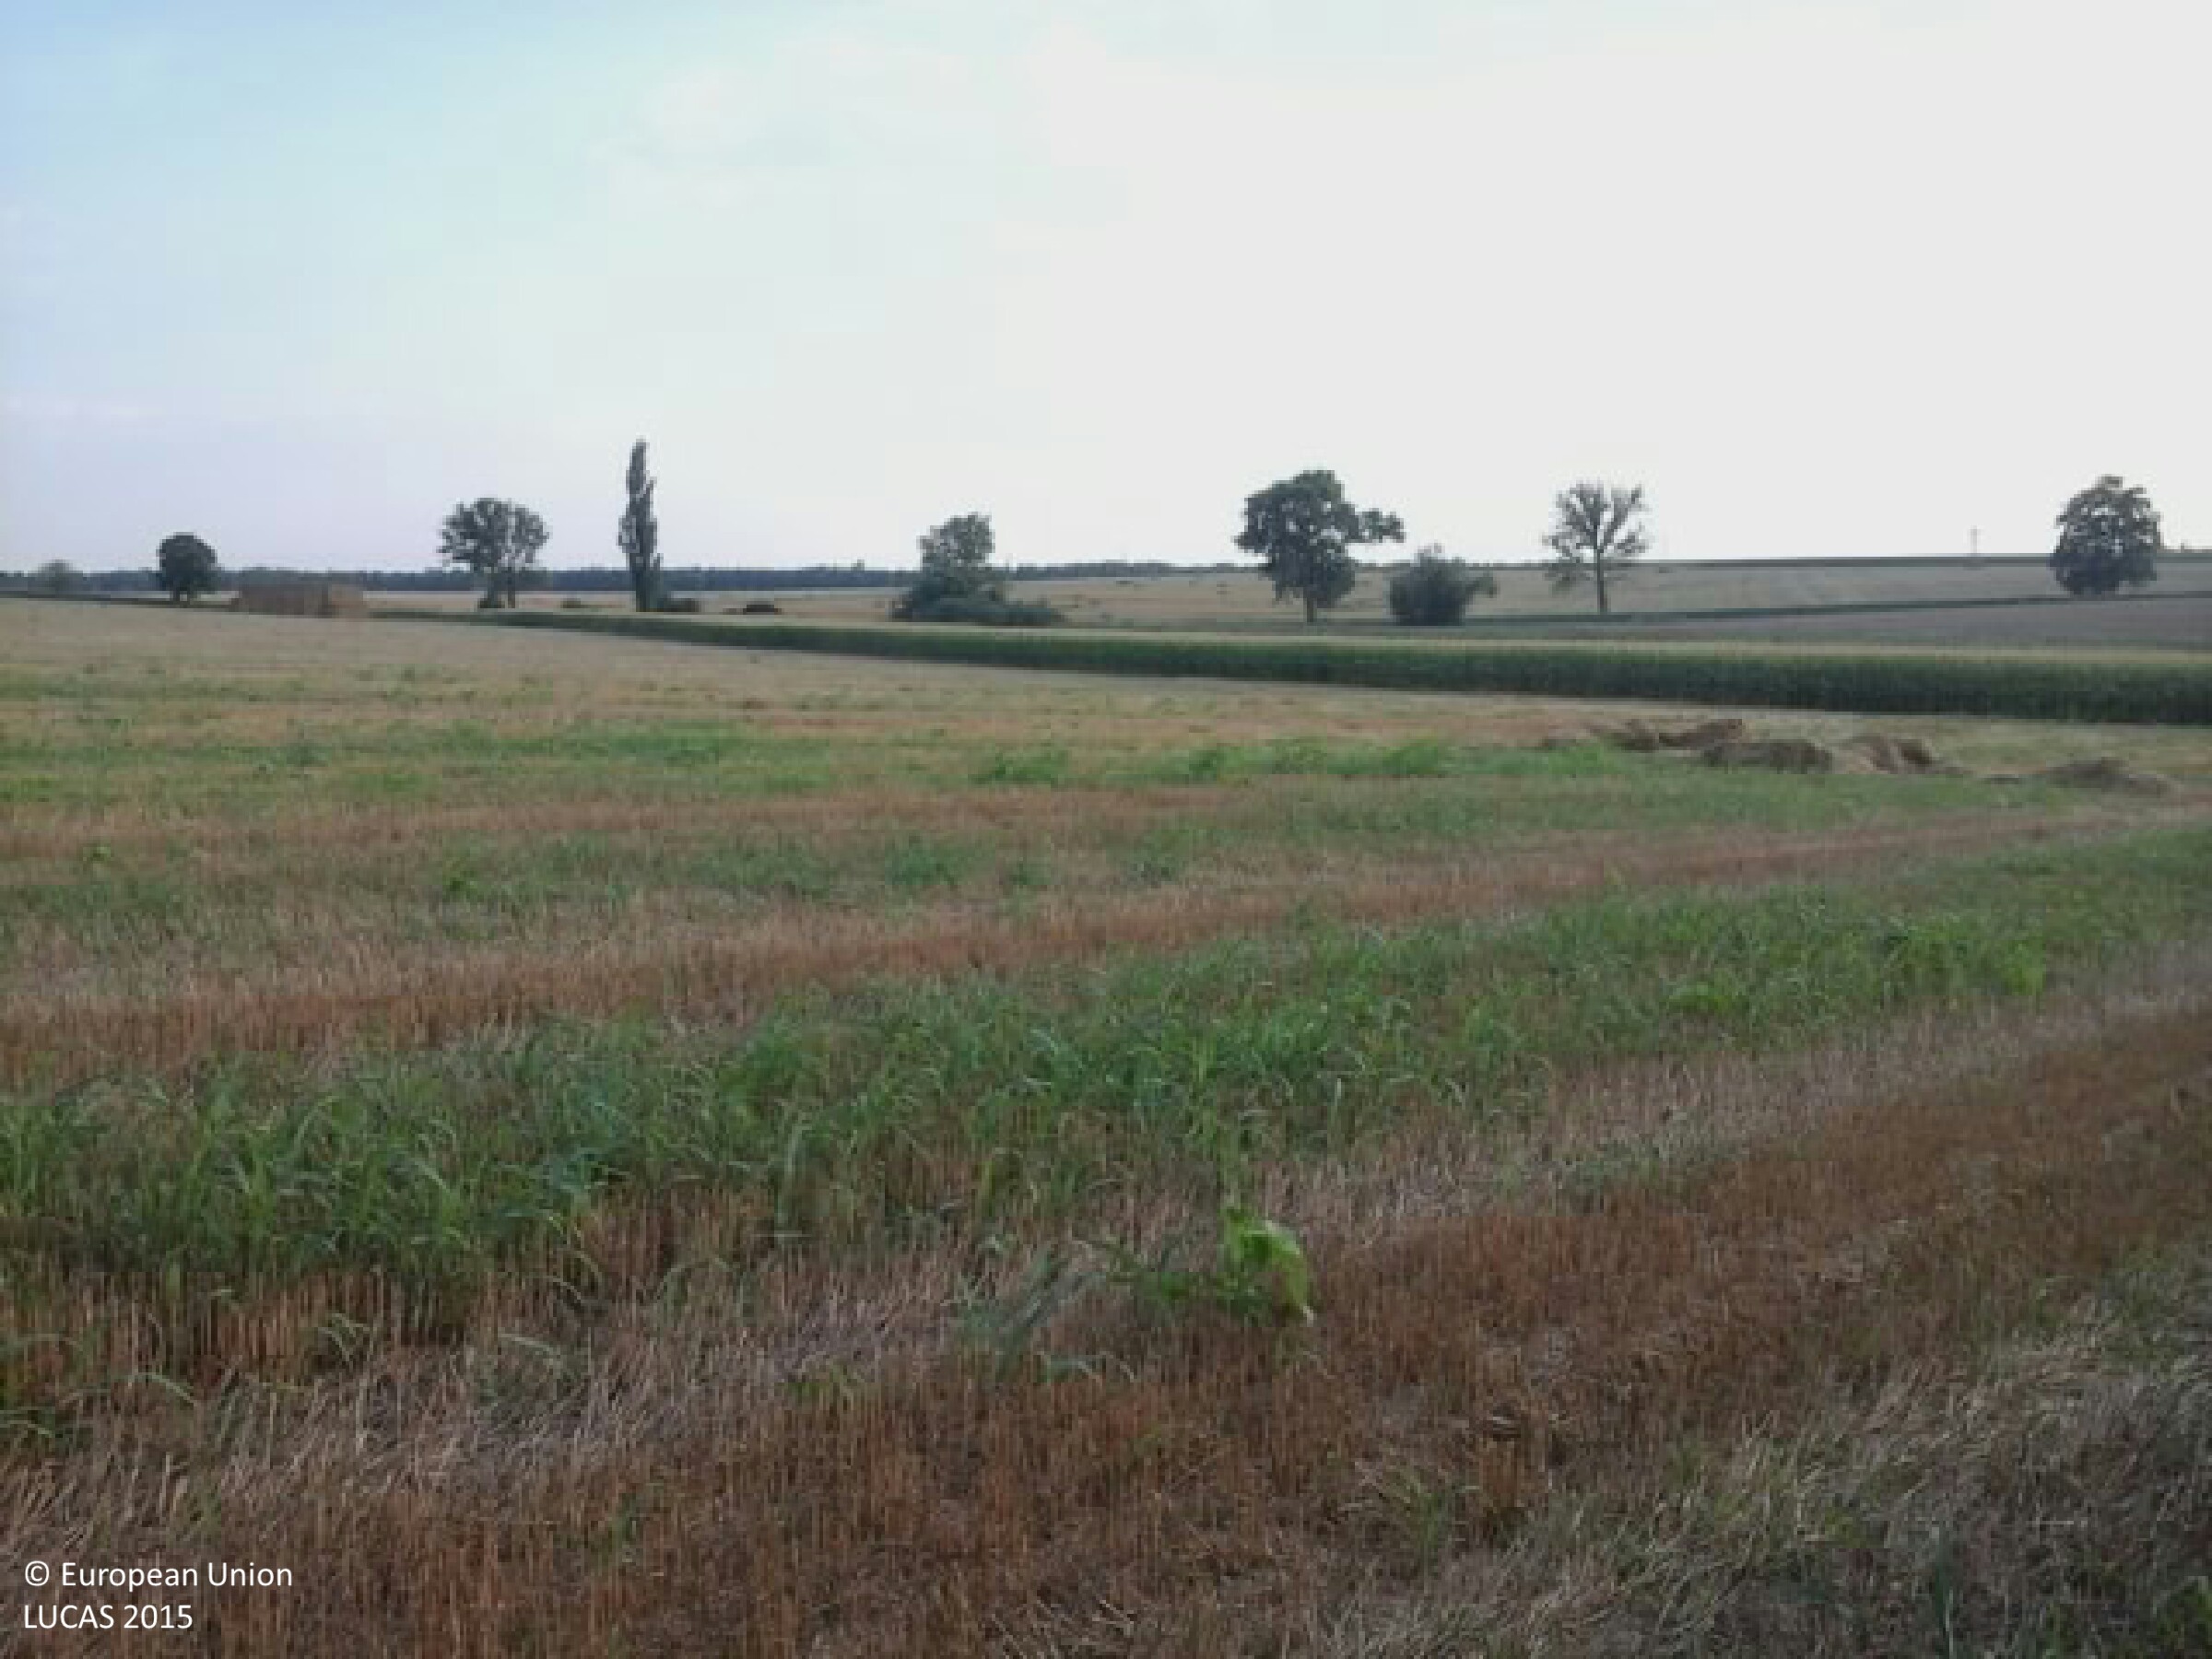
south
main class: Cropland
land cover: Sunflower
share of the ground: > 75 %
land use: Agriculture (excluding fallow land and kitchen gardens)
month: August
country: HU
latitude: 46.6870
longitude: 18.2073
